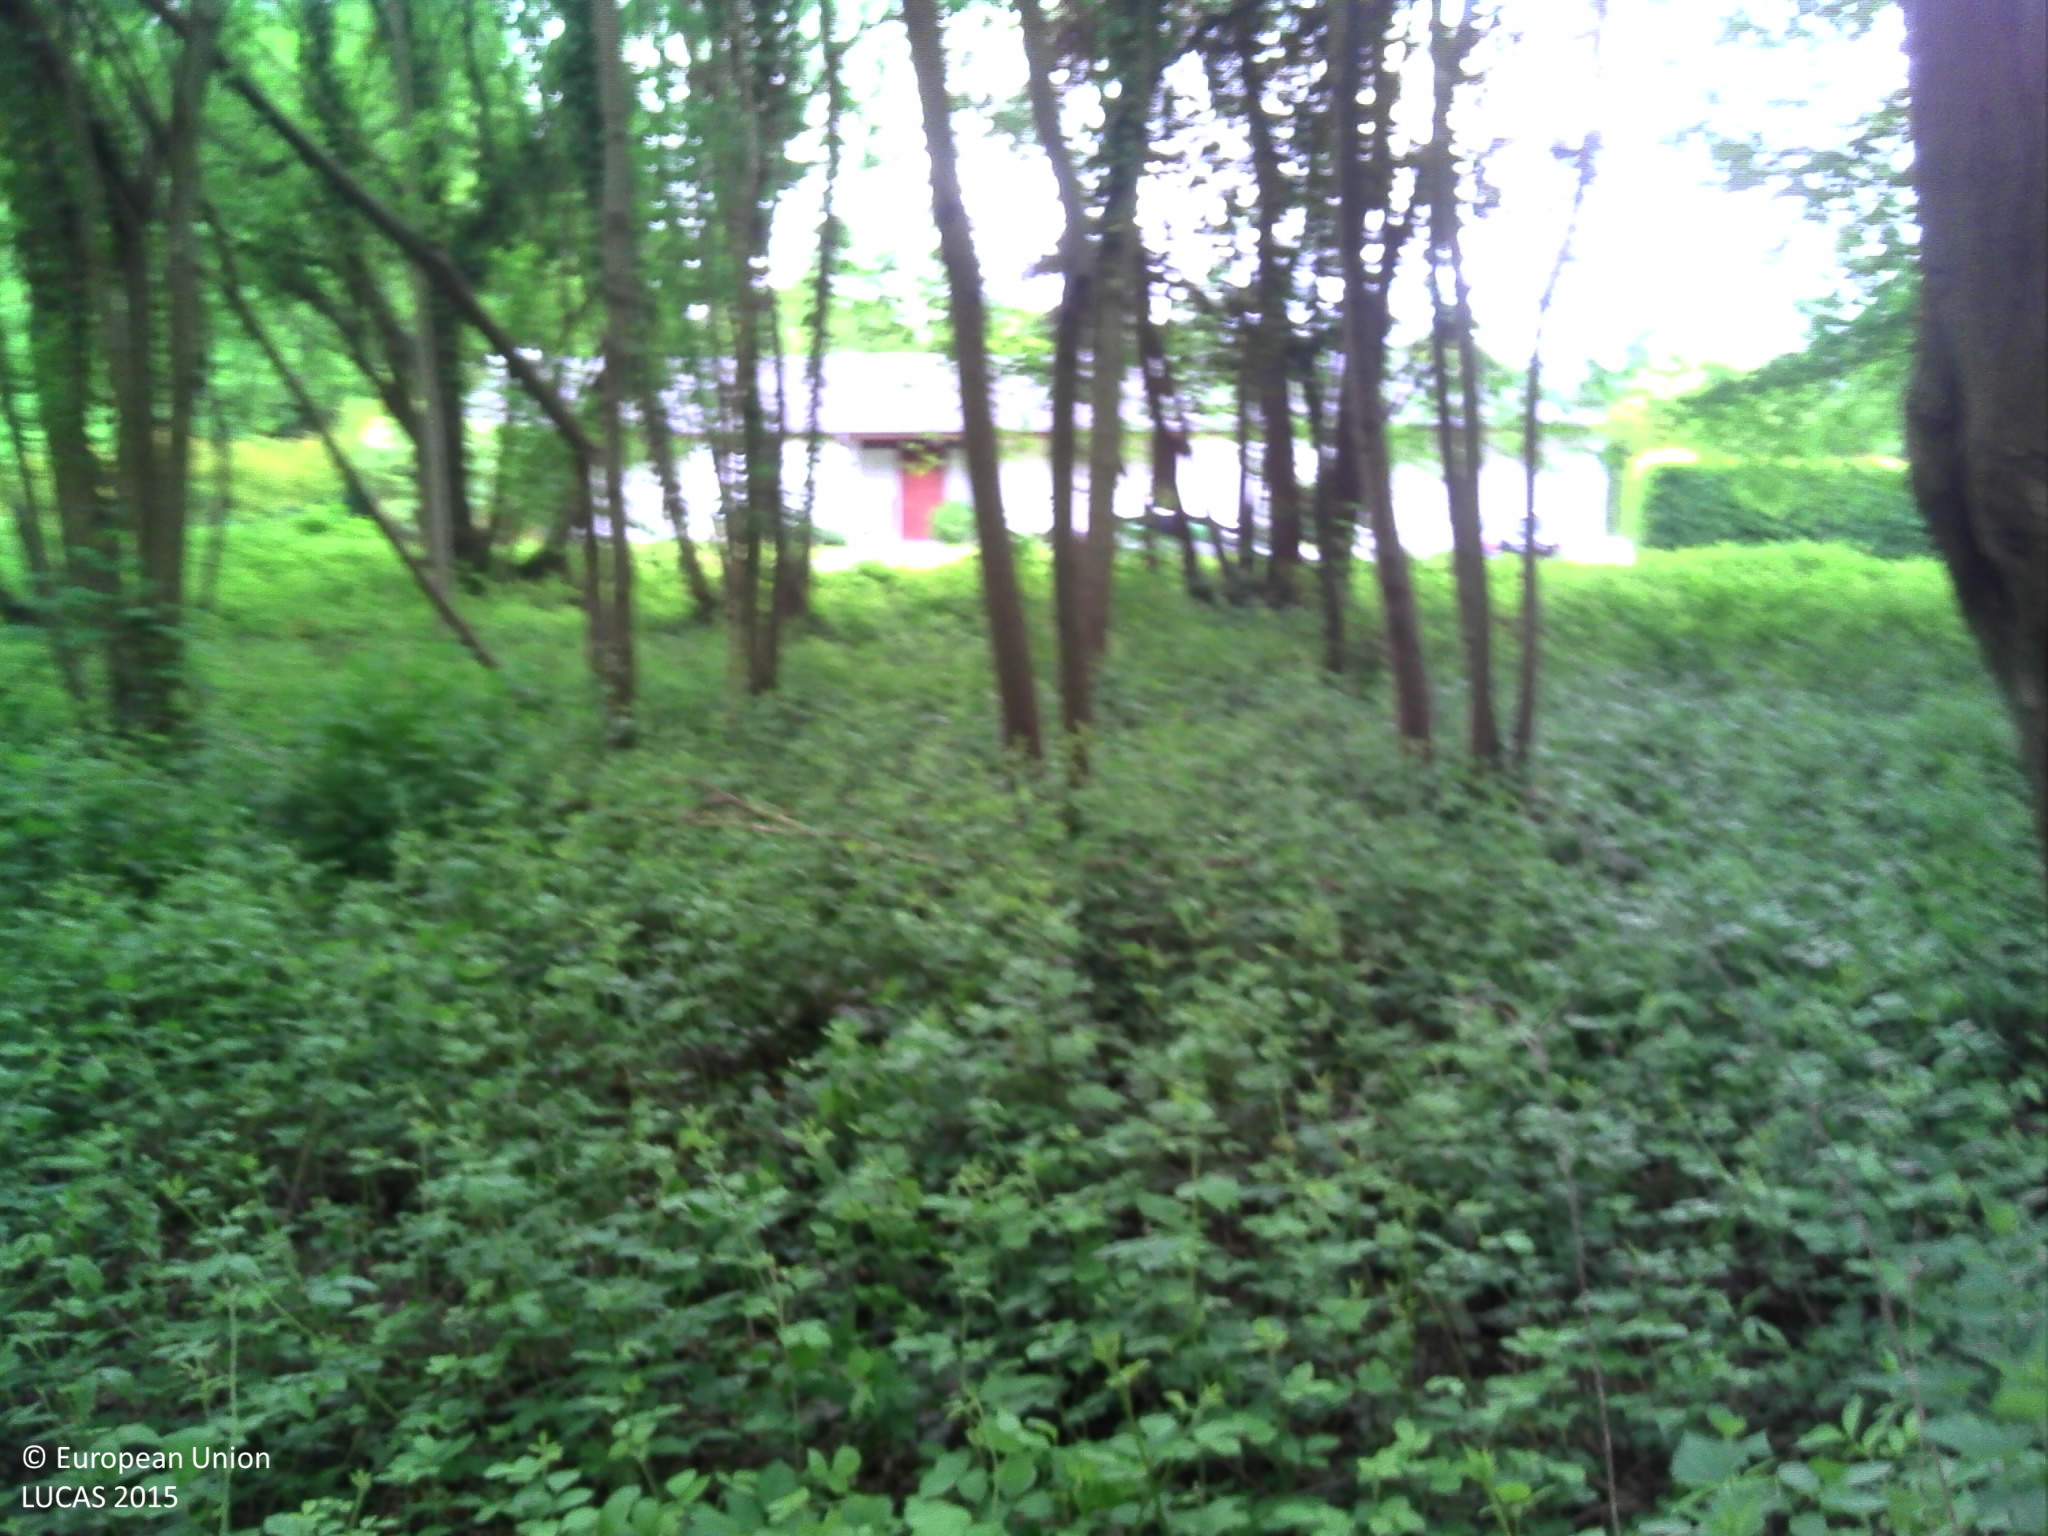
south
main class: Woodland
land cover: Broadleaved woodland
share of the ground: > 75 %
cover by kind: broadleaved forest trees 100 %
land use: Forestry
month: May
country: BE
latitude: 50.6984
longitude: 4.4599
